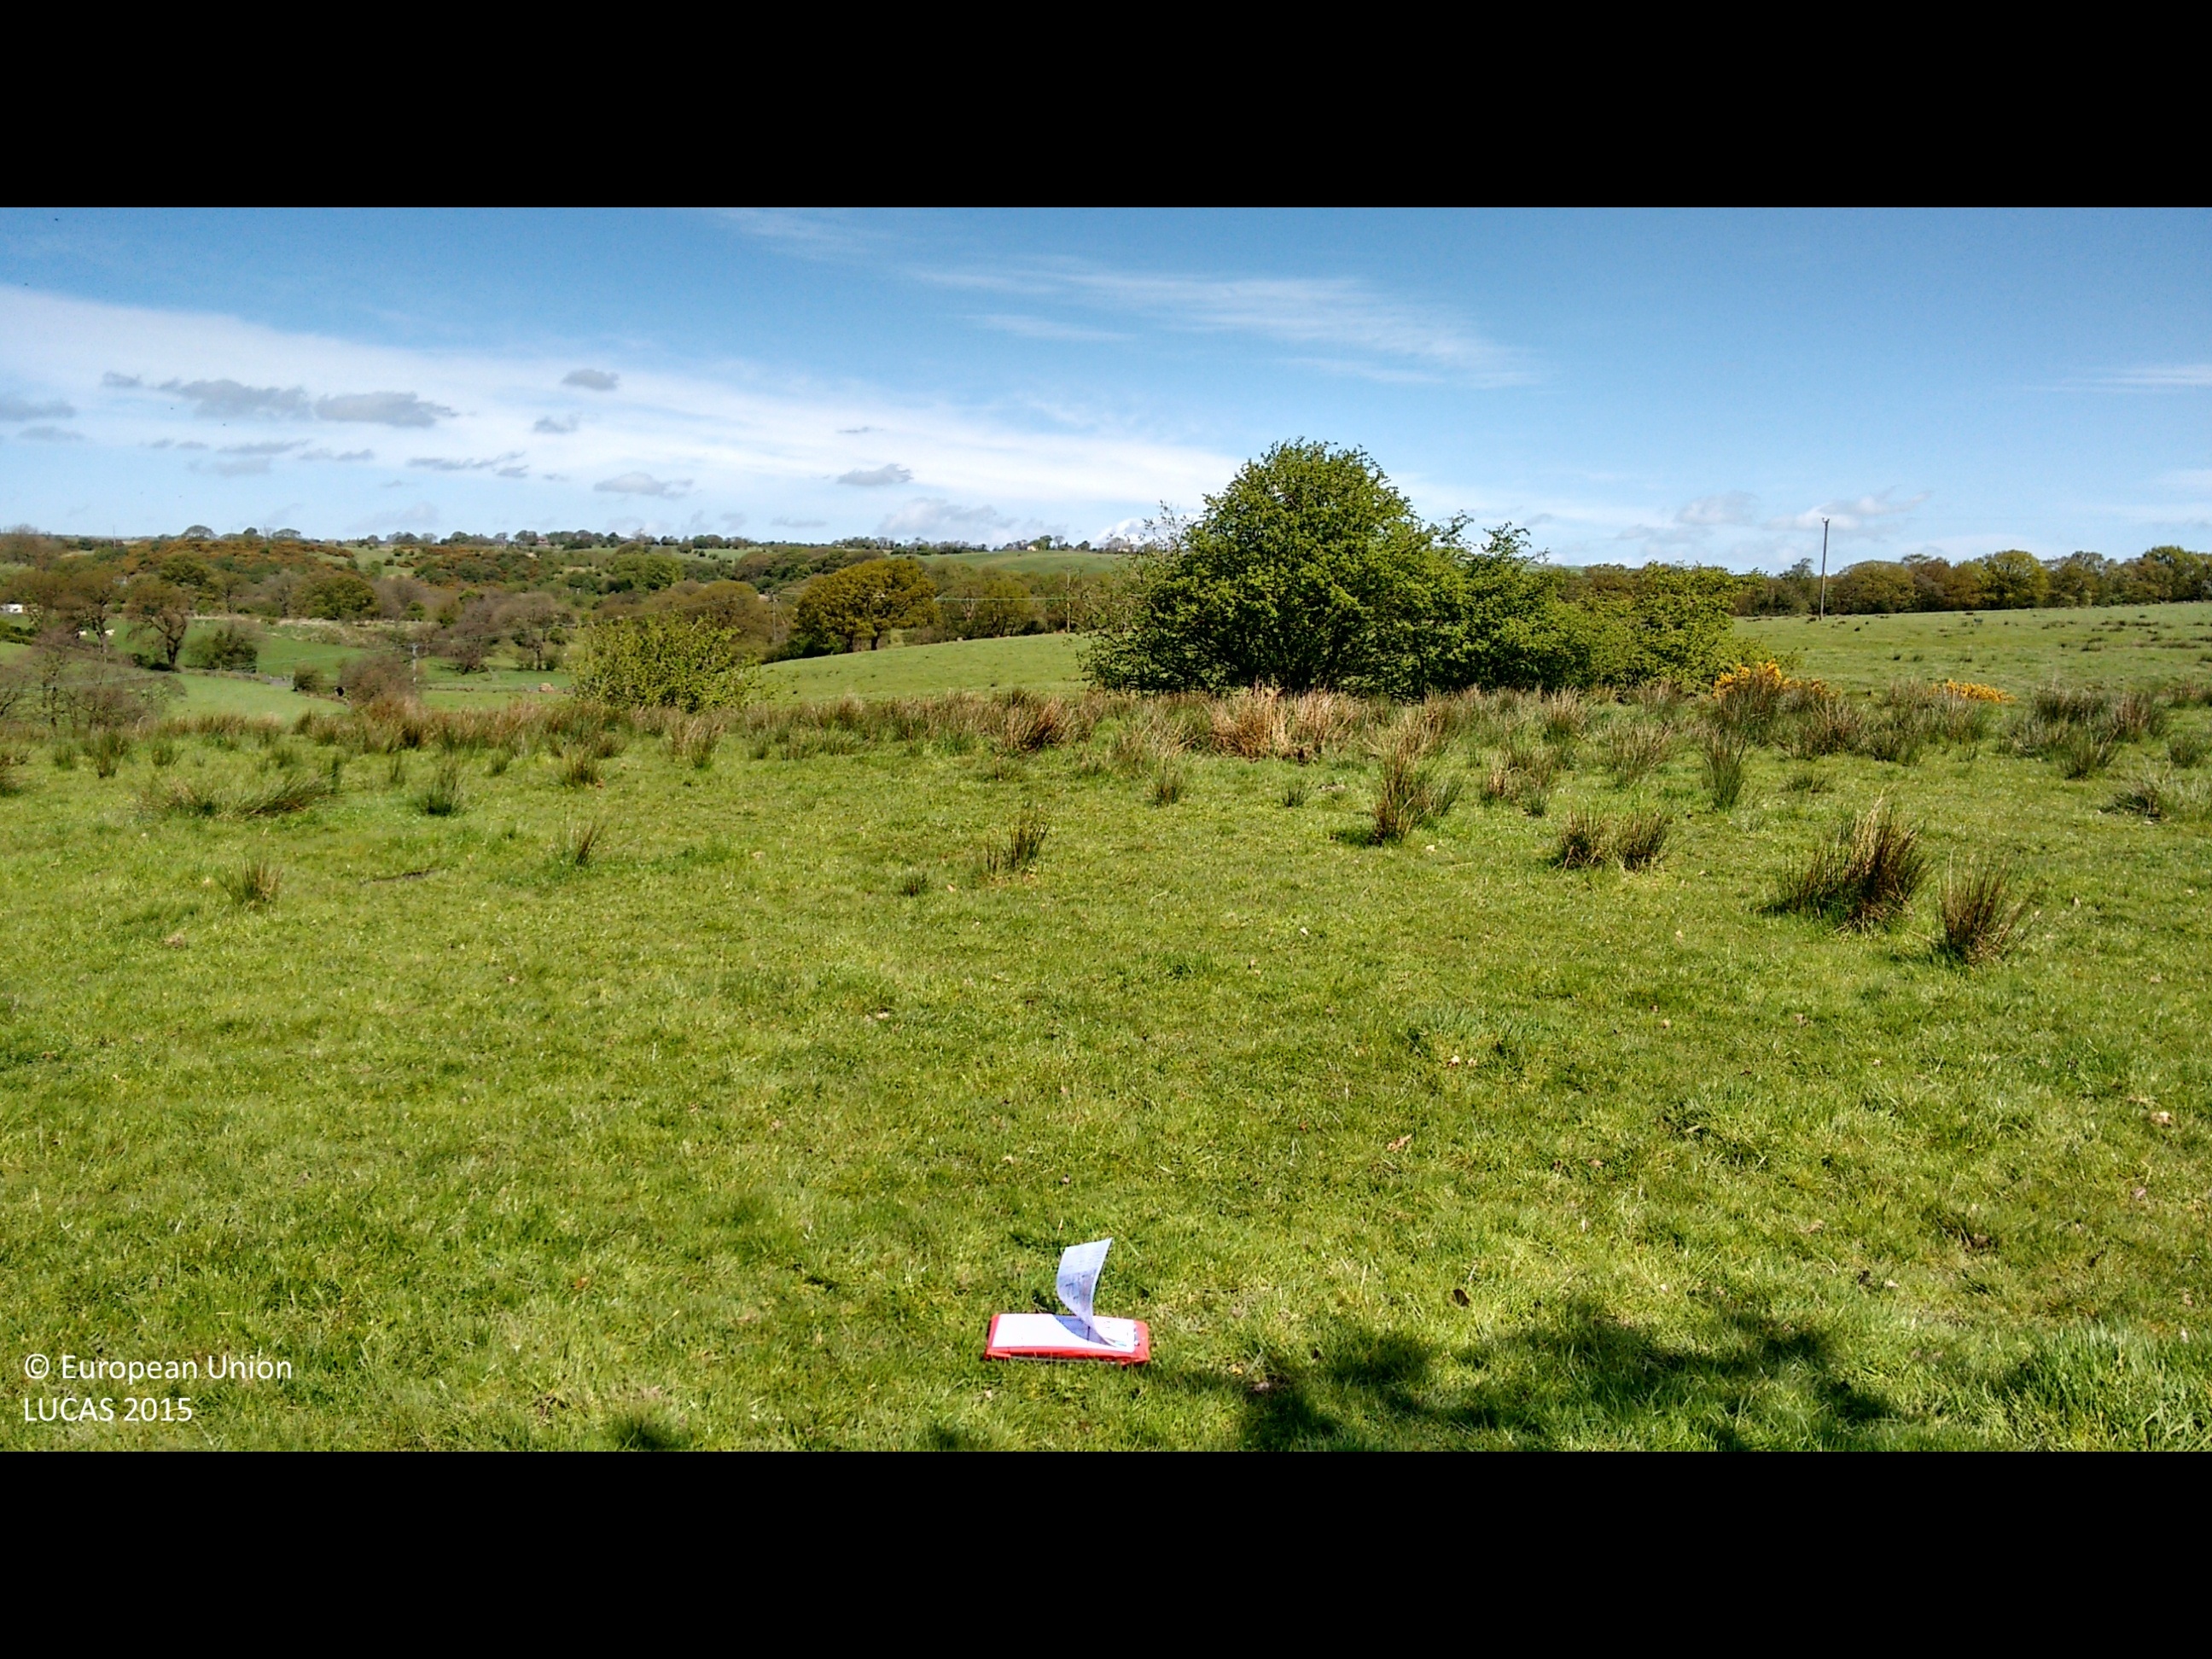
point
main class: Grassland
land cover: Grassland without tree/shrub cover
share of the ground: > 75 %
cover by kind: herbaceous plants 100 %
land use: Agriculture (excluding fallow land and kitchen gardens)
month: May
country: GB
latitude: 53.6707
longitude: -2.5844
